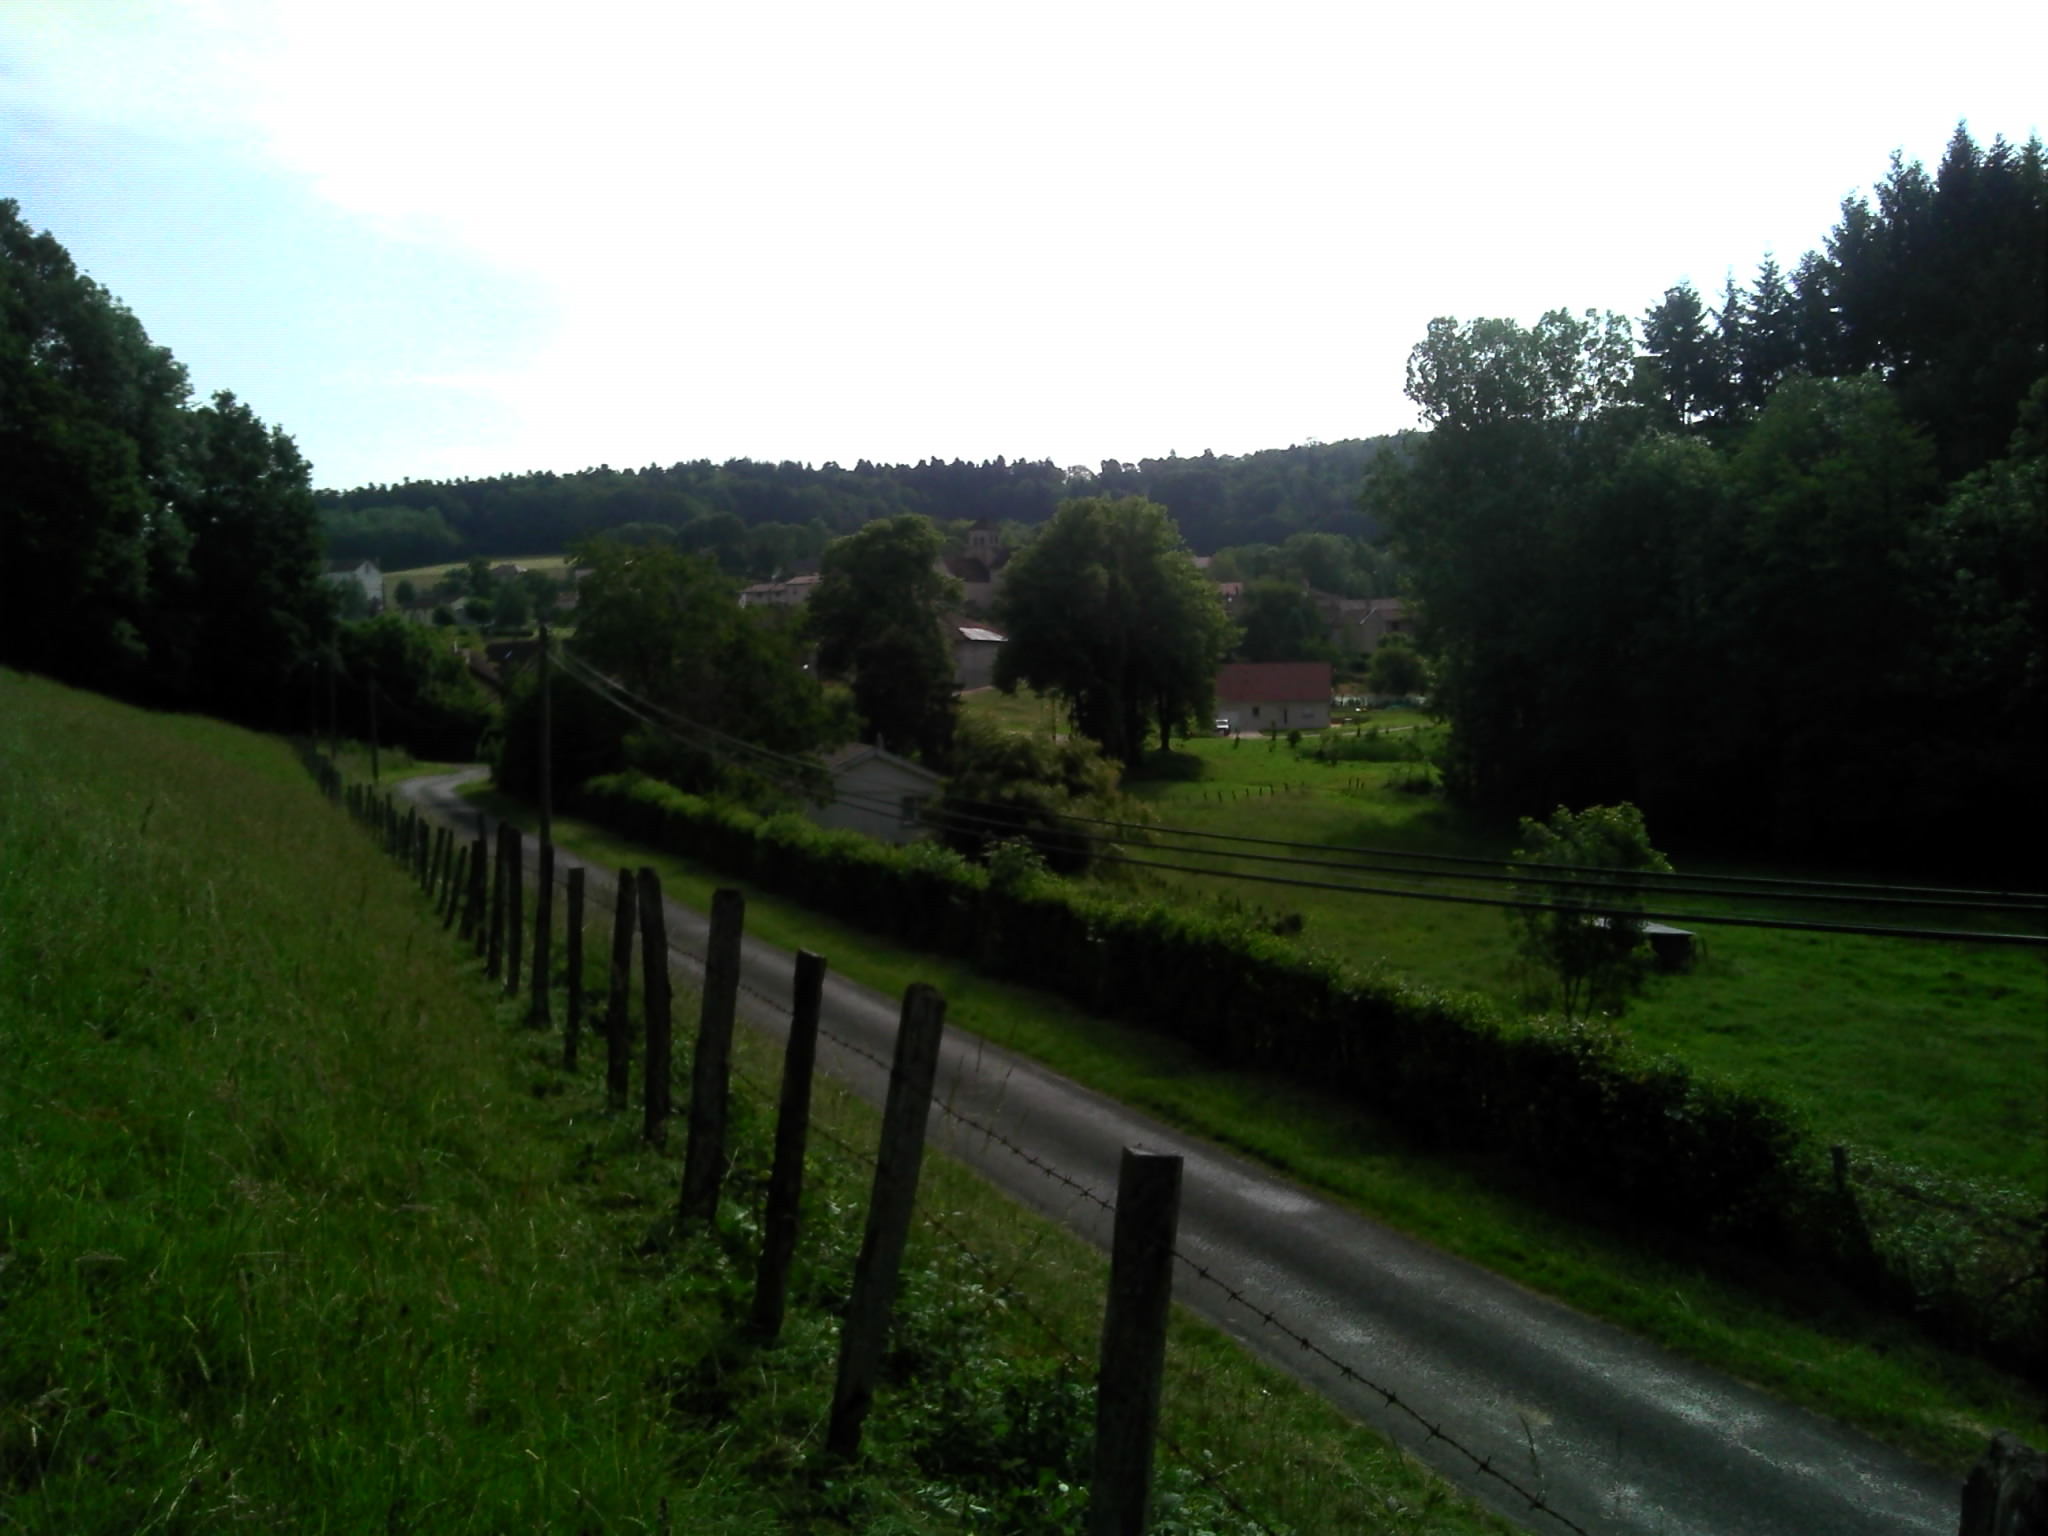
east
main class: Grassland
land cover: Grassland without tree/shrub cover
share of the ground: > 75 %
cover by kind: herbaceous plants 100 %
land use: Agriculture (excluding fallow land and kitchen gardens)
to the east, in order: Grassland without tree/shrub cover; Fences; Electric lines; Grass margins; Paved roads, cycling and walking lanes; Grass margins; Managed hedges; Fences; Spontaneously vegetated surfaces; Grassland without tree/shrub cover; Fences; Ditches and canals; Spontaneously vegetated surfaces; Grassland without tree/shrub cover; Paved roads, cycling and walking lanes; Grassland without tree/shrub cover; Other fresh vegetables; Fences; Grassland with sparse tree/shrub cover
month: May
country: FR
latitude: 46.4668
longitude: 5.3536
